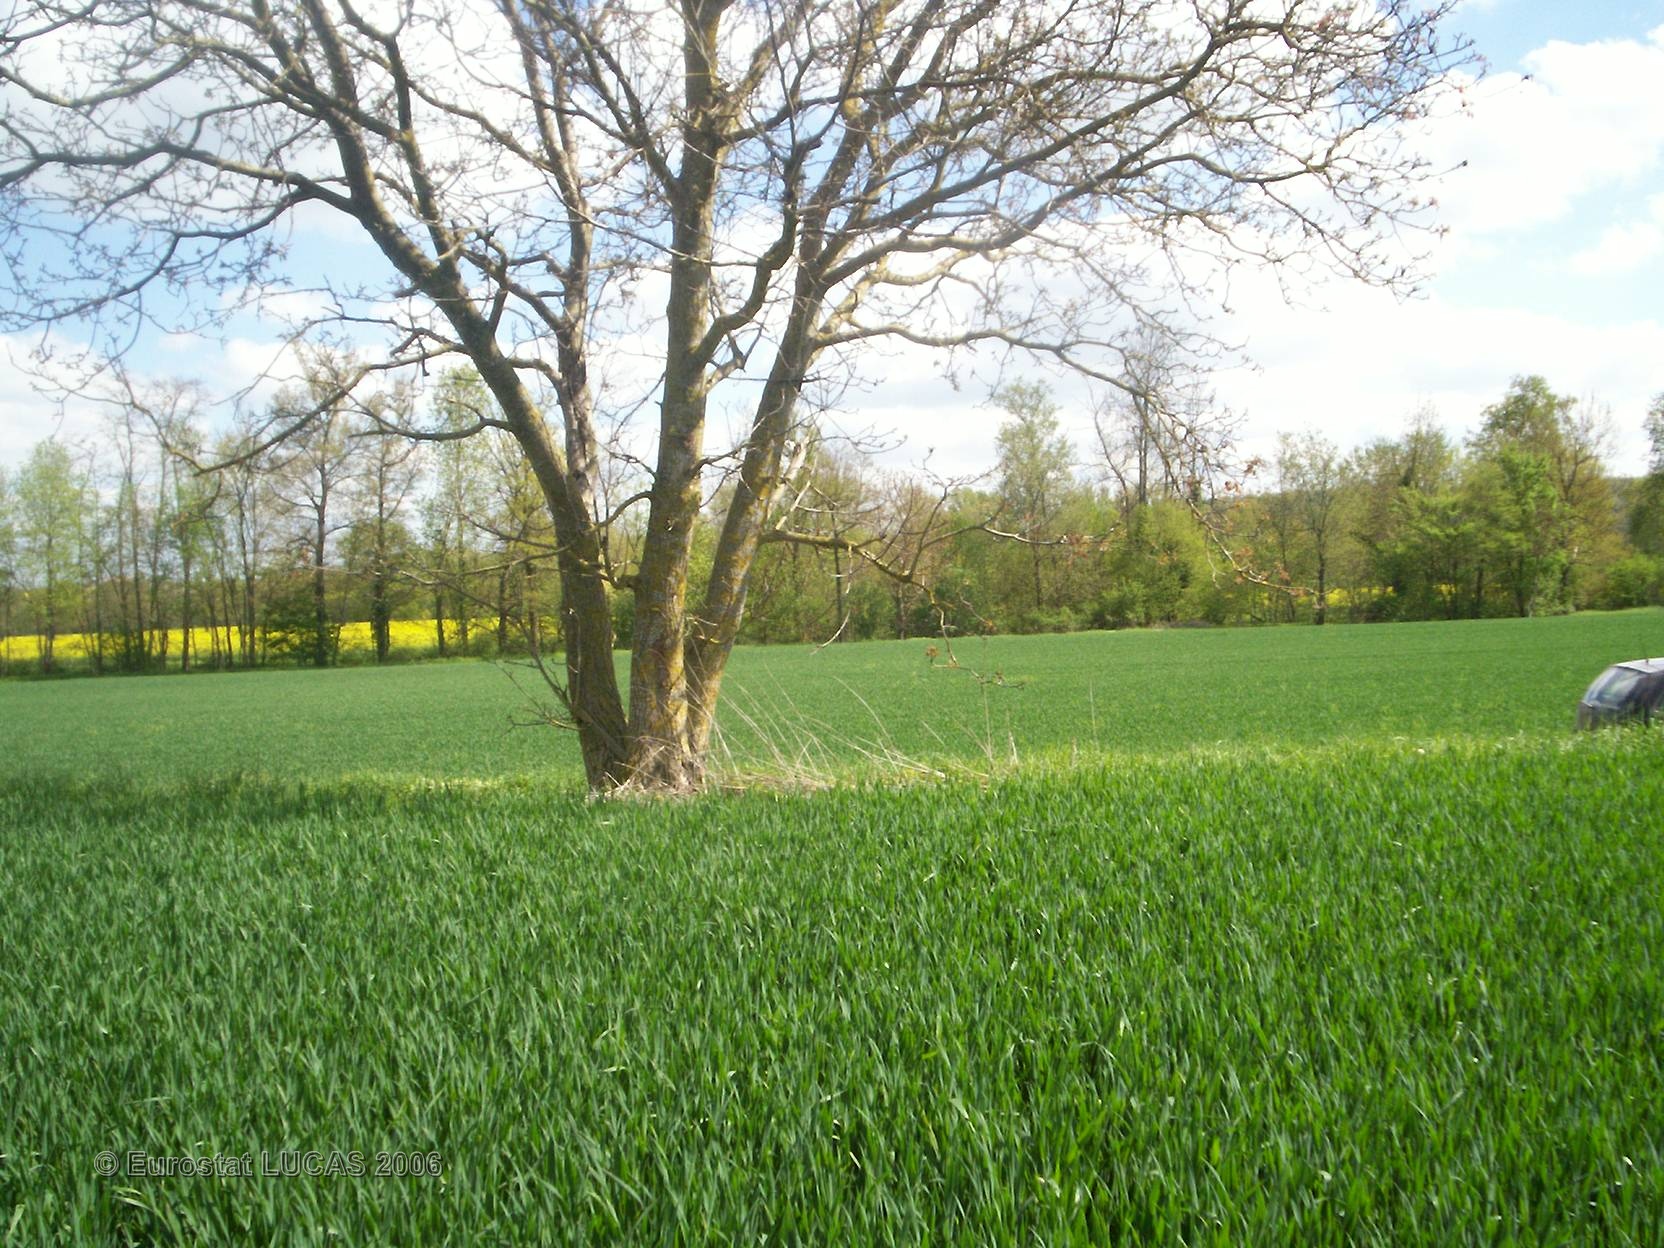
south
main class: Cropland
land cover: Common wheat
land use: Agriculture (excluding fallow land and kitchen gardens)
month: April
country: FR
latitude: 46.2621
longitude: 3.2133
